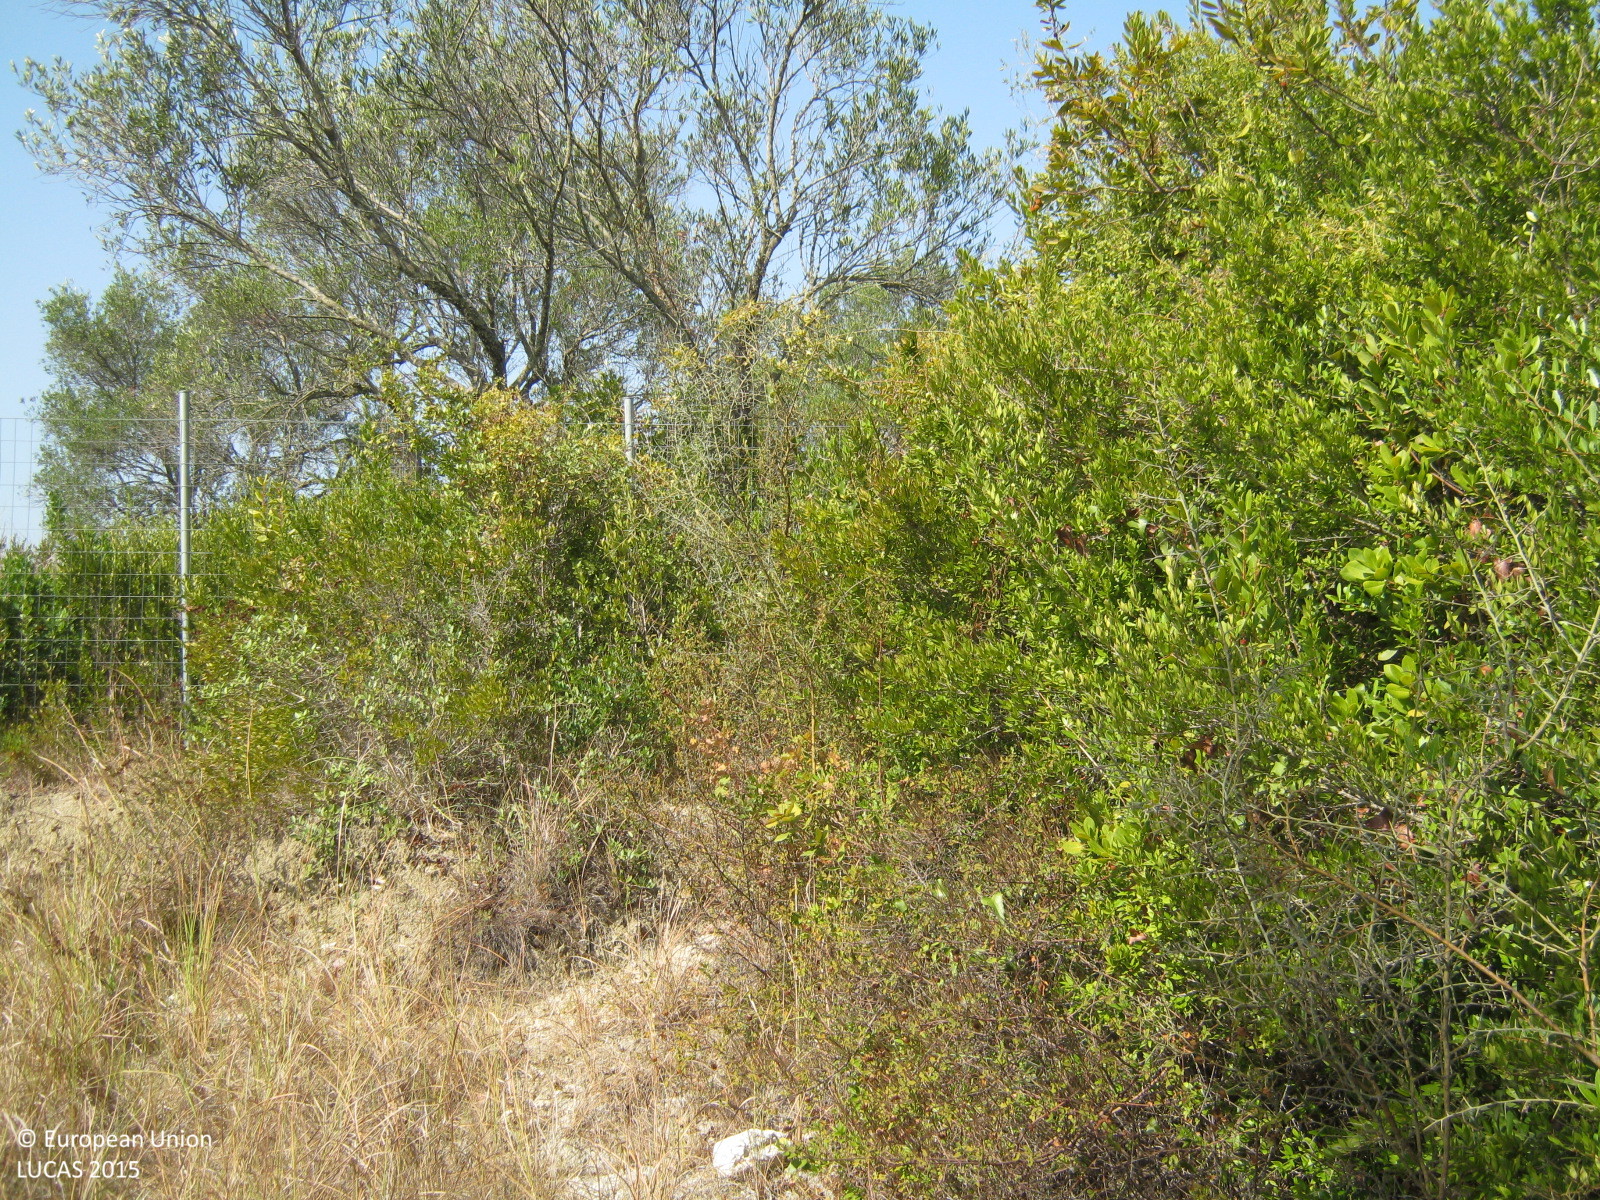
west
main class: Shrubland
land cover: Shrubland with sparse tree cover
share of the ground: > 75 %
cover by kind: shrubs 95 %, broadleaved forest trees 5 %
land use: Semi-natural and natural areas not in use
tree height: < 5 m
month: September
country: GR
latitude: 39.4703
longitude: 19.9340
